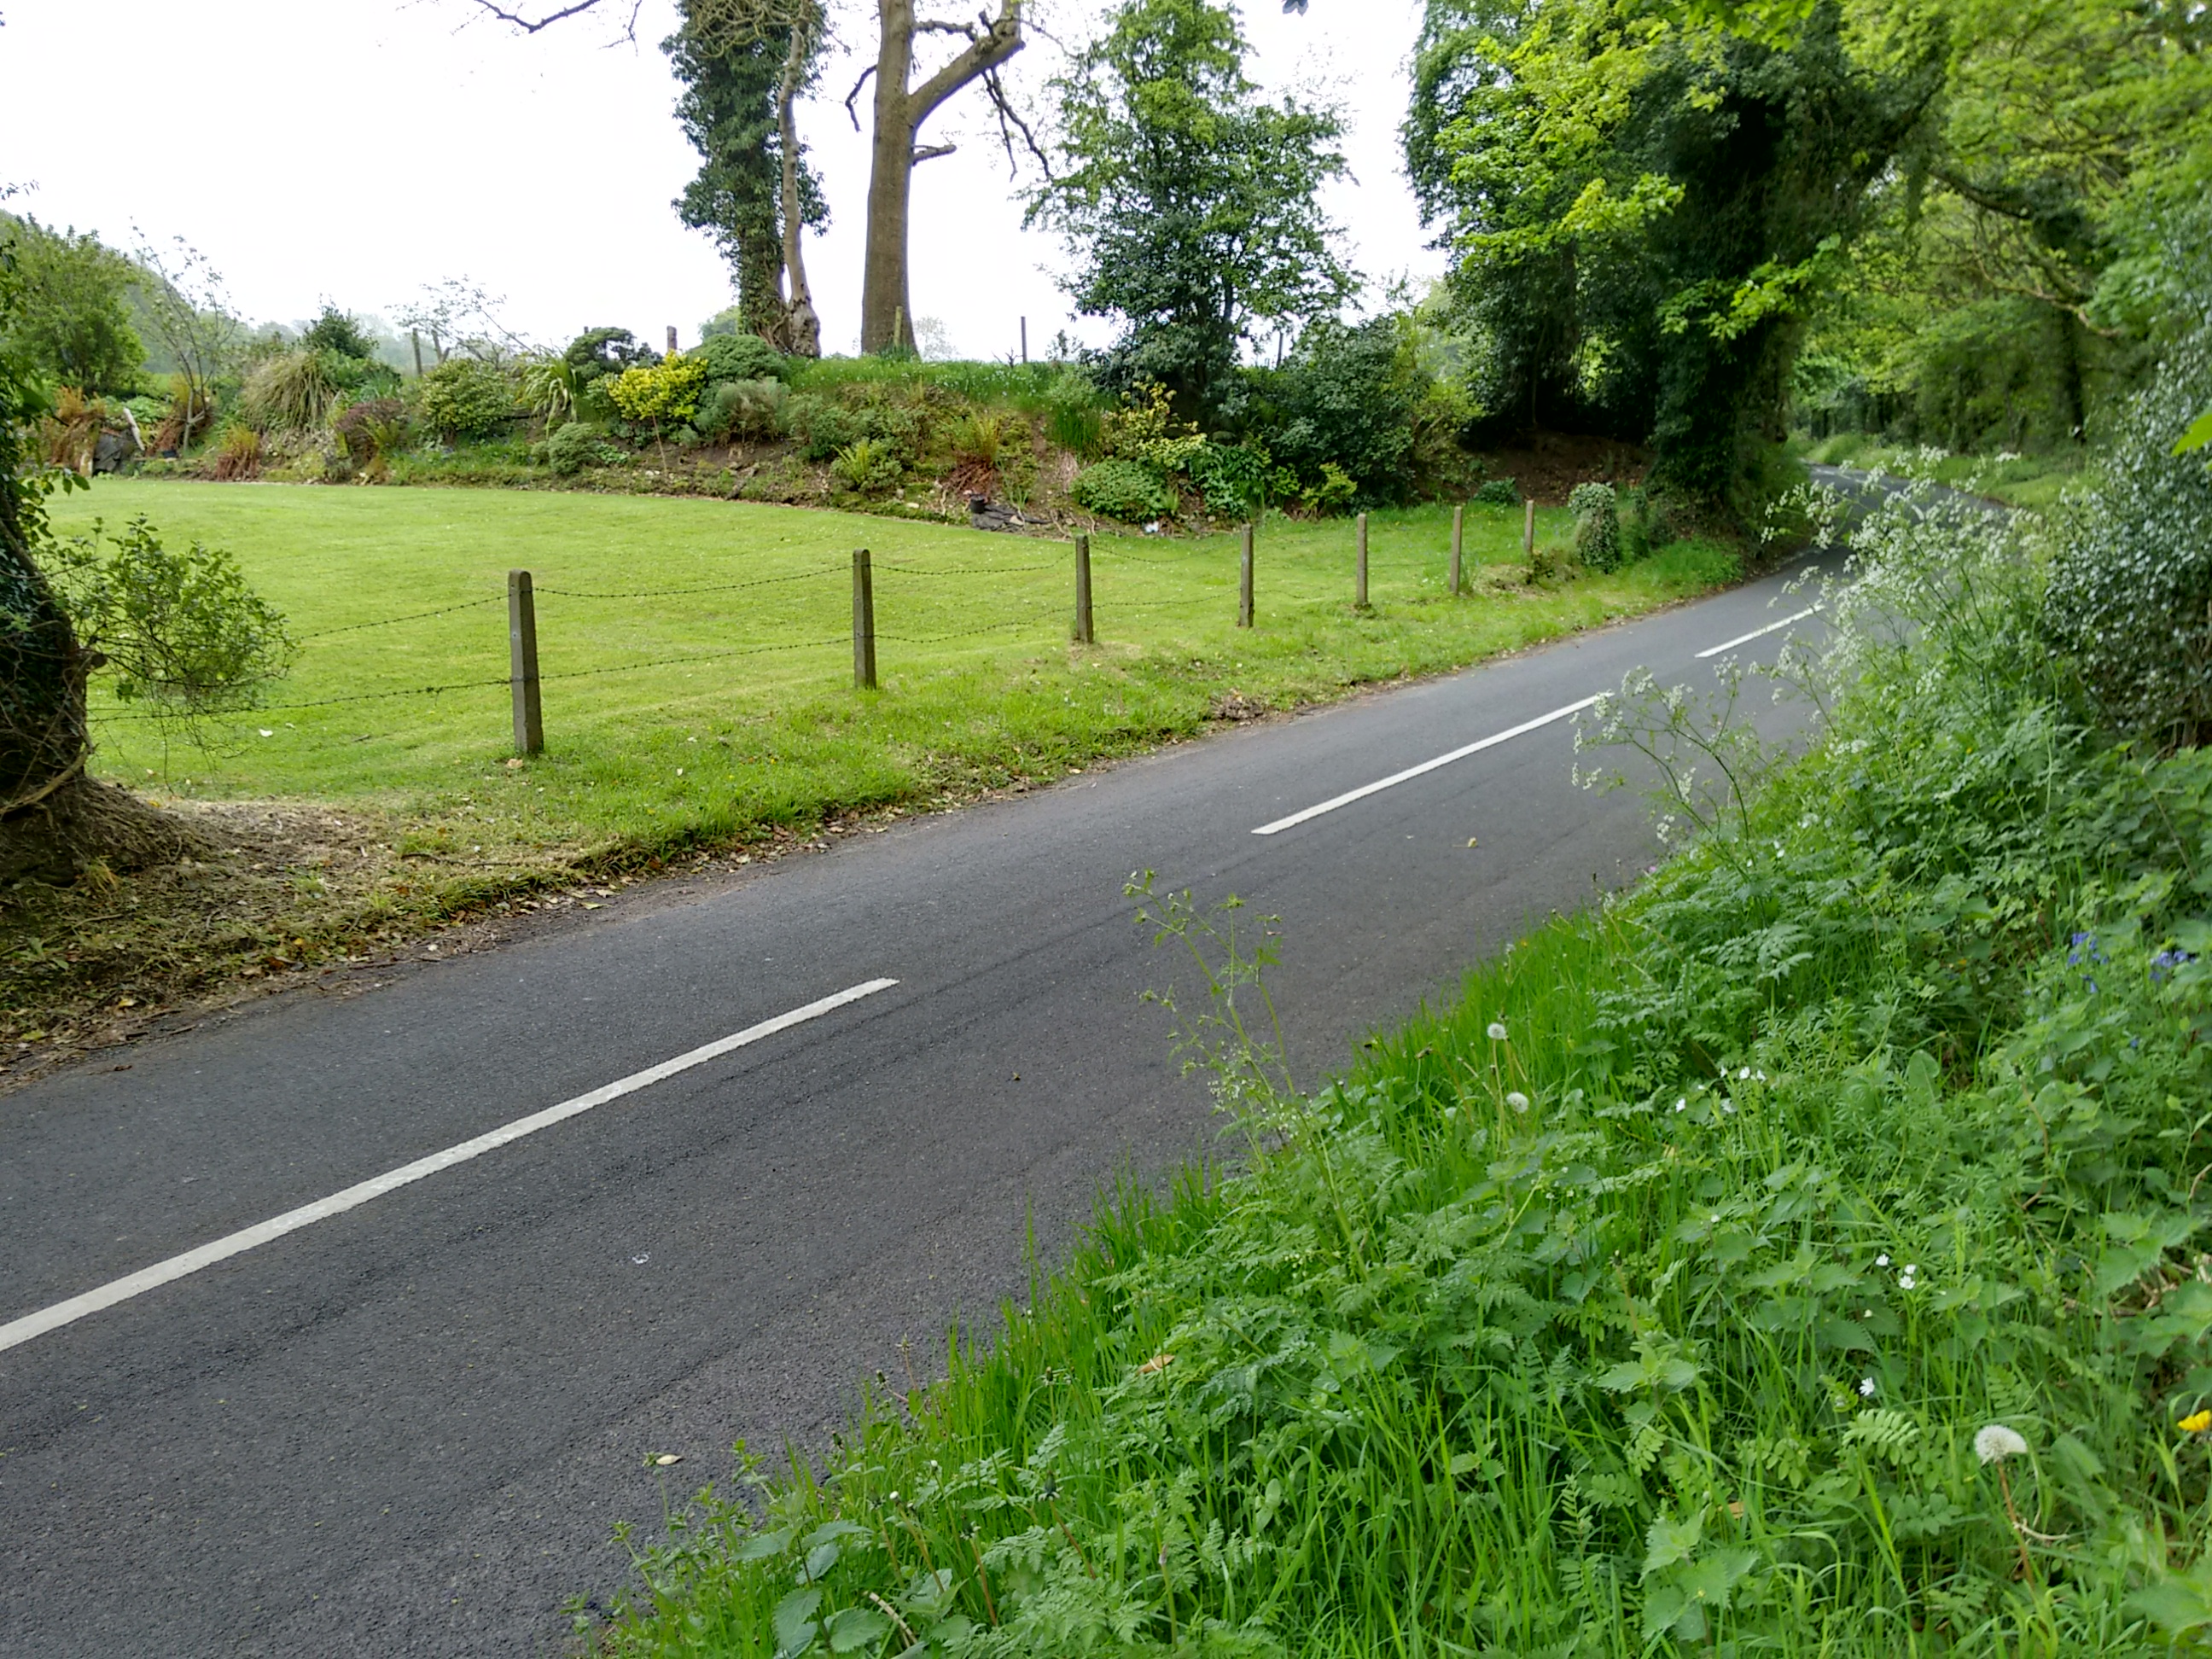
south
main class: Woodland
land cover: Broadleaved woodland
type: floodplain forest
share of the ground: > 75 %
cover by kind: broadleaved forest trees 100 %
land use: Semi-natural and natural areas not in use
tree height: > 5 m
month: May
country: GB
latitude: 55.0374
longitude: -7.0221
